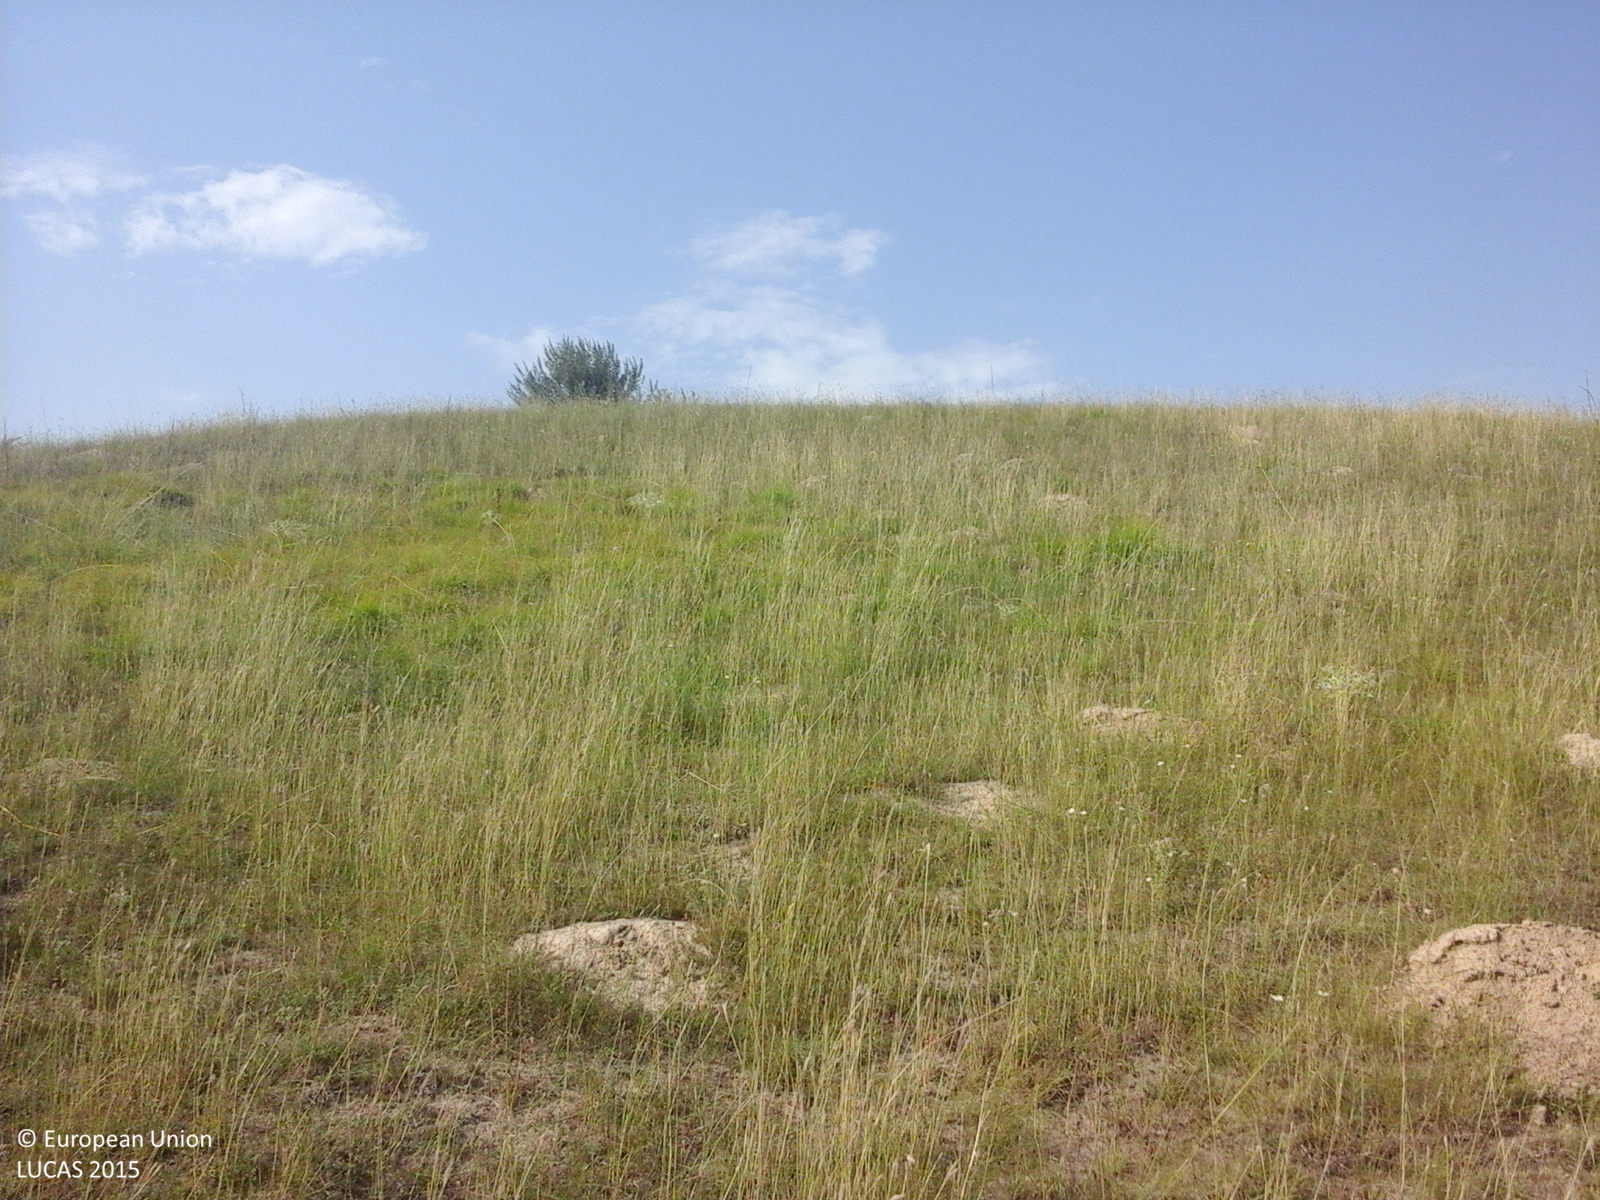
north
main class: Grassland
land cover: Grassland without tree/shrub cover
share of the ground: > 75 %
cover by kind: herbaceous plants 100 %
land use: Agriculture (excluding fallow land and kitchen gardens)
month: August
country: RO
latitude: 44.1755
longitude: 27.9253
